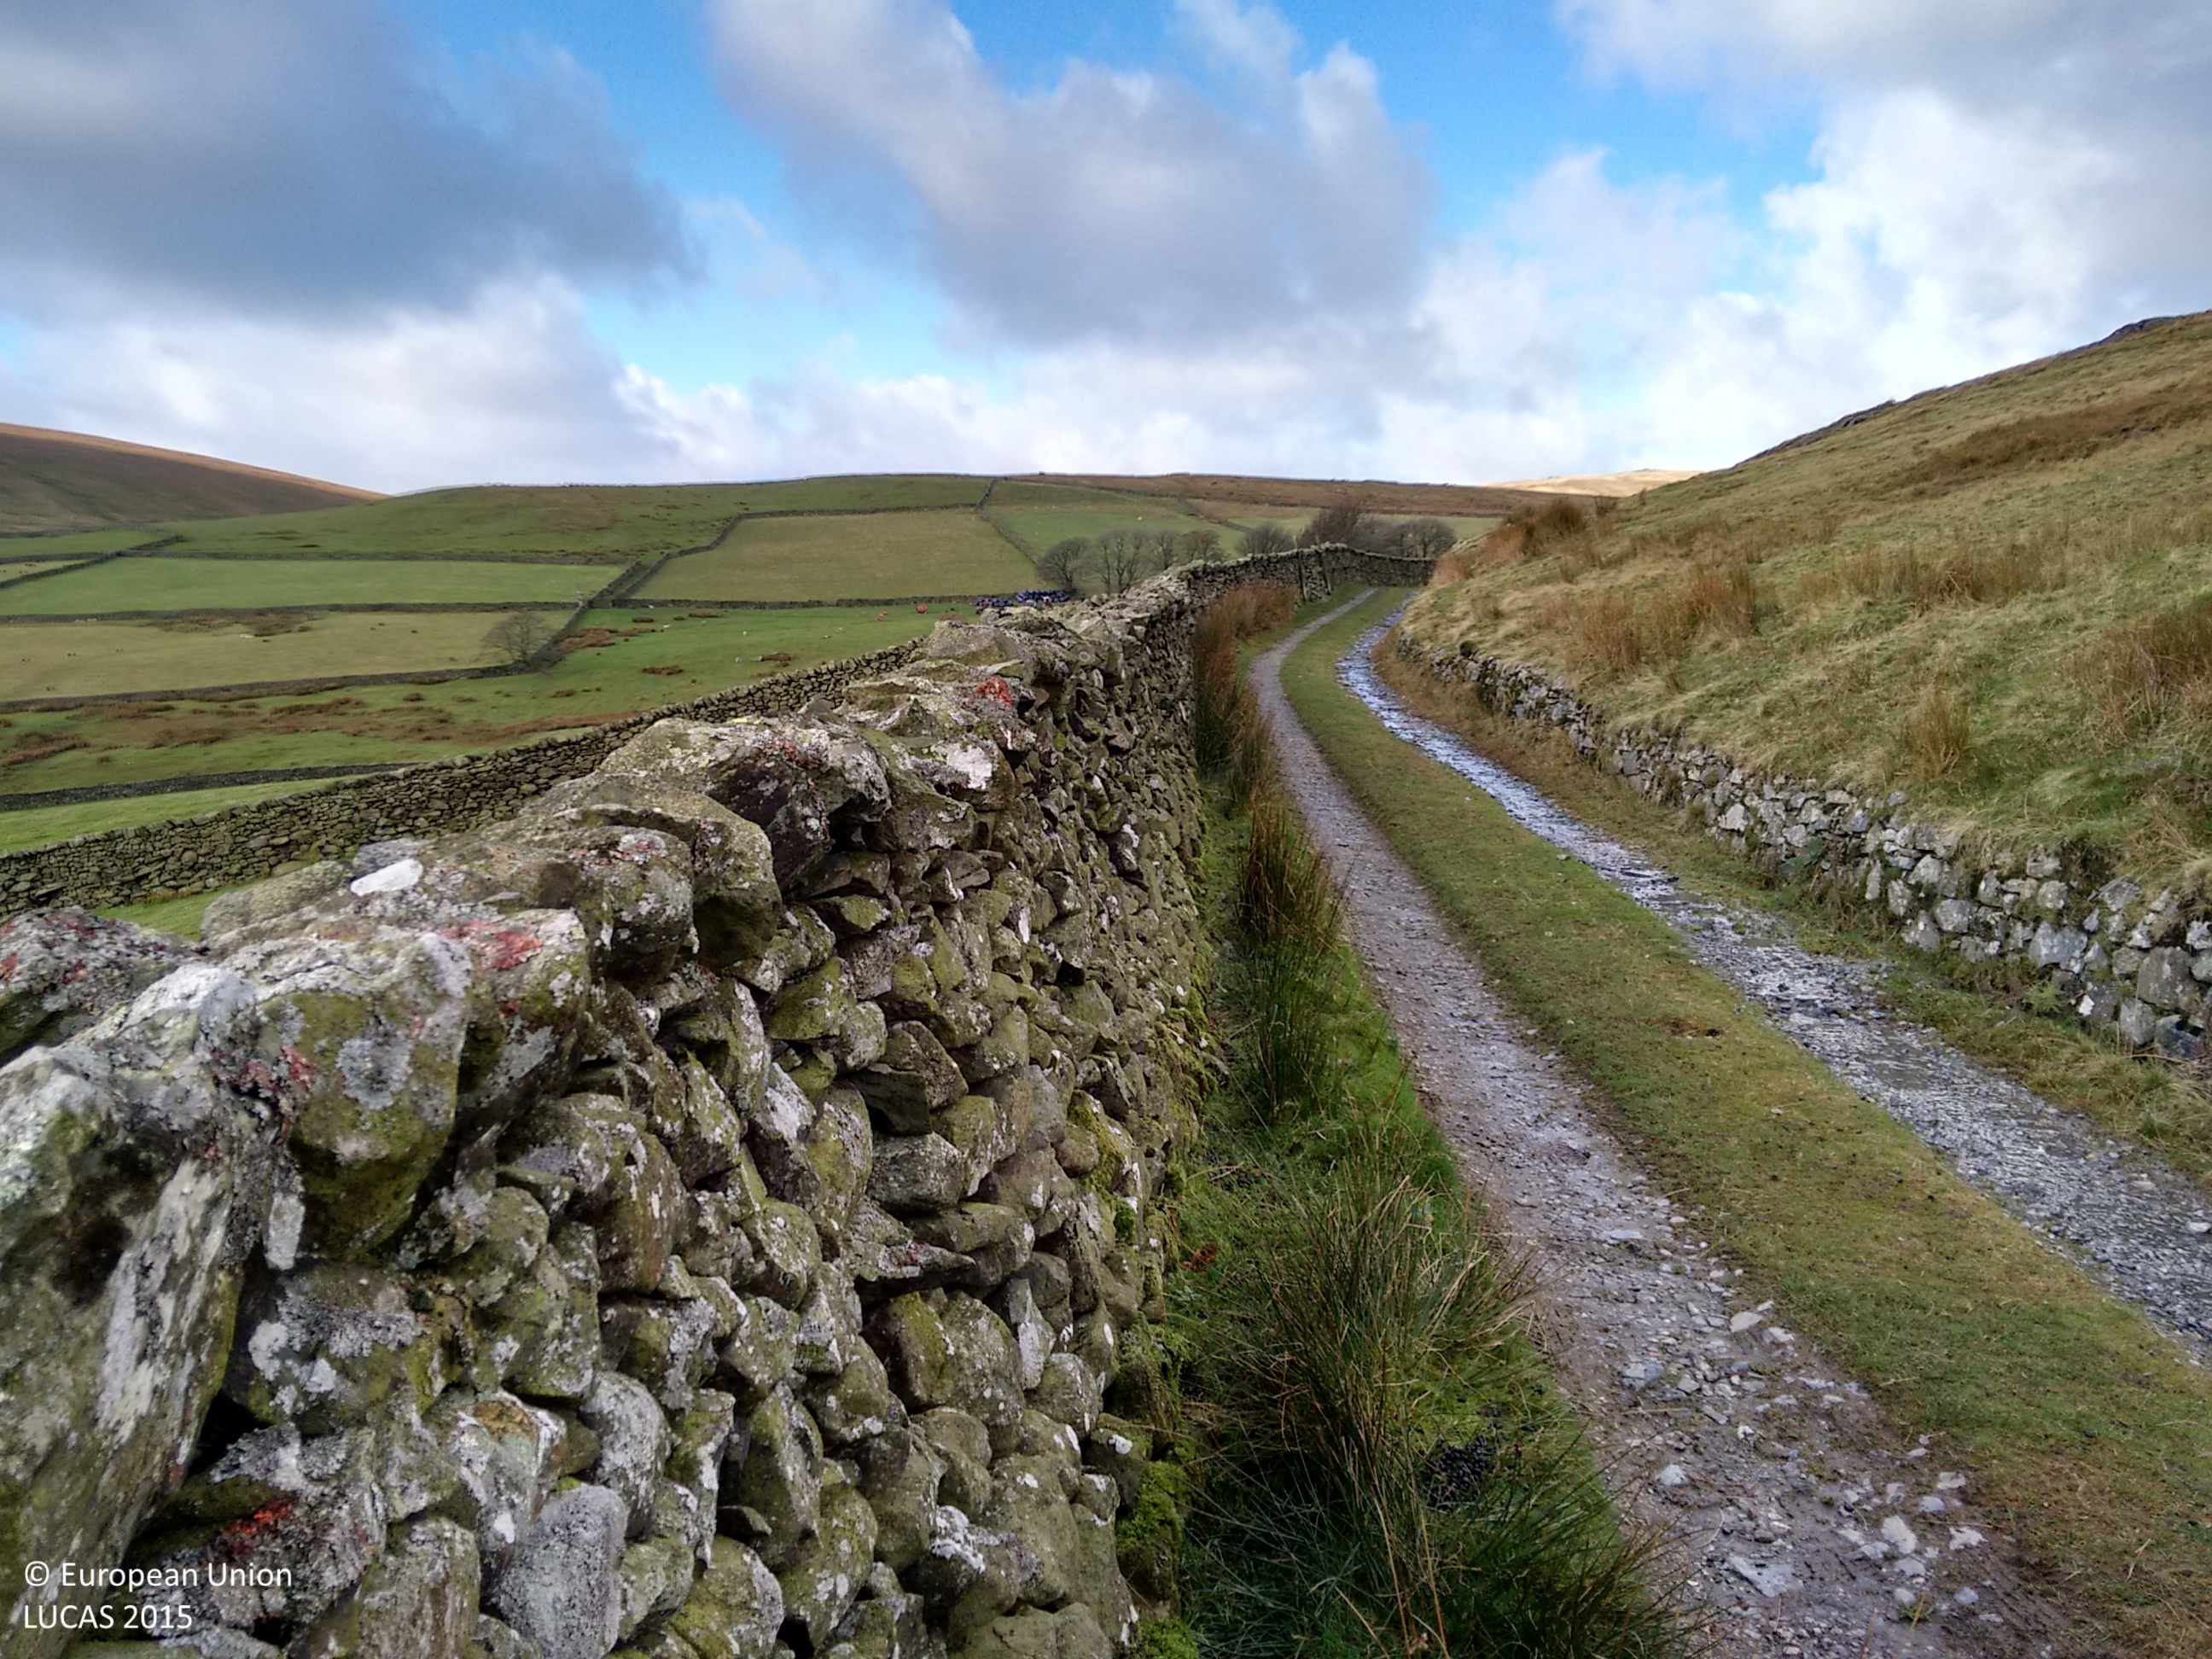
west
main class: Grassland
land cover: Grassland without tree/shrub cover
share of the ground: > 75 %
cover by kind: herbaceous plants 100 %
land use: Agriculture (excluding fallow land and kitchen gardens)
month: November
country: GB
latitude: 54.2899
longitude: -3.2745
